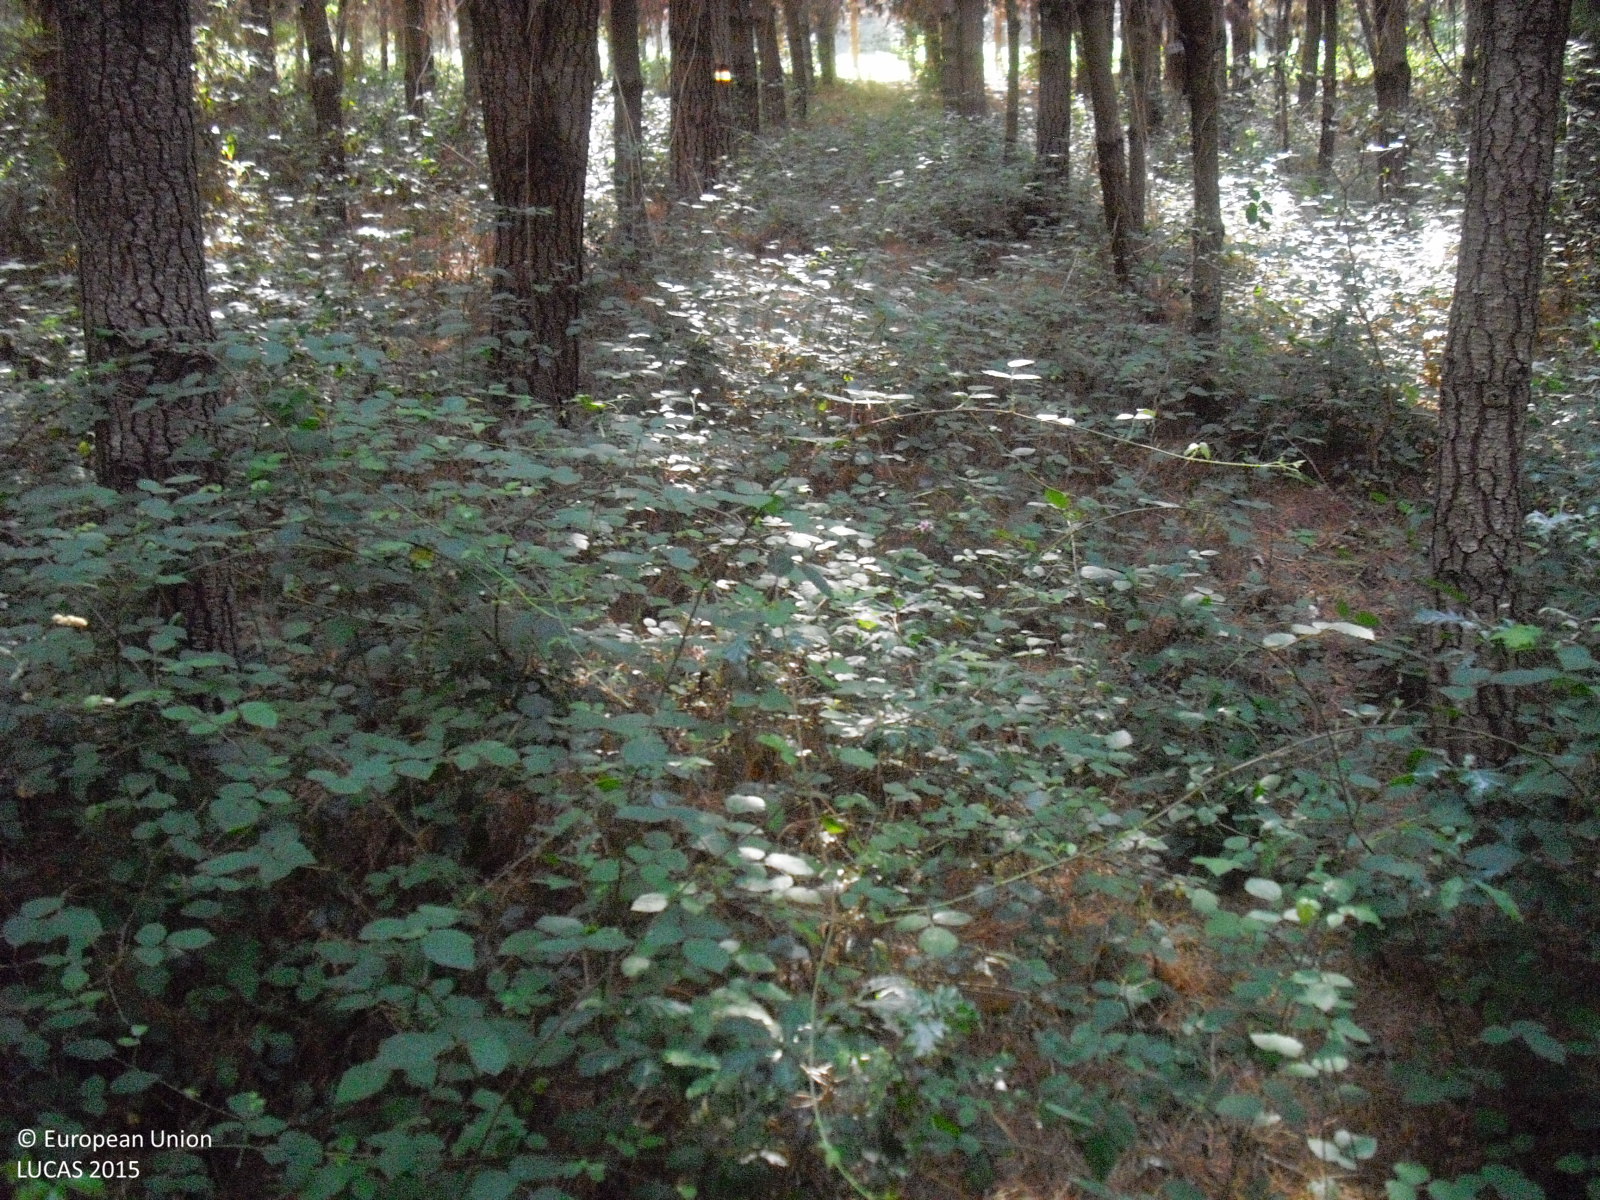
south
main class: Woodland
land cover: Pine dominated coniferous woodland
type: hemiboreal forest and nemoral coniferous forest and mixed broadleaved-coniferous forest
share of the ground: > 75 %
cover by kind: coniferous forest trees 100 %
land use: Forestry
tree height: > 5 m
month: July
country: ES
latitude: 42.6639
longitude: -7.5058
